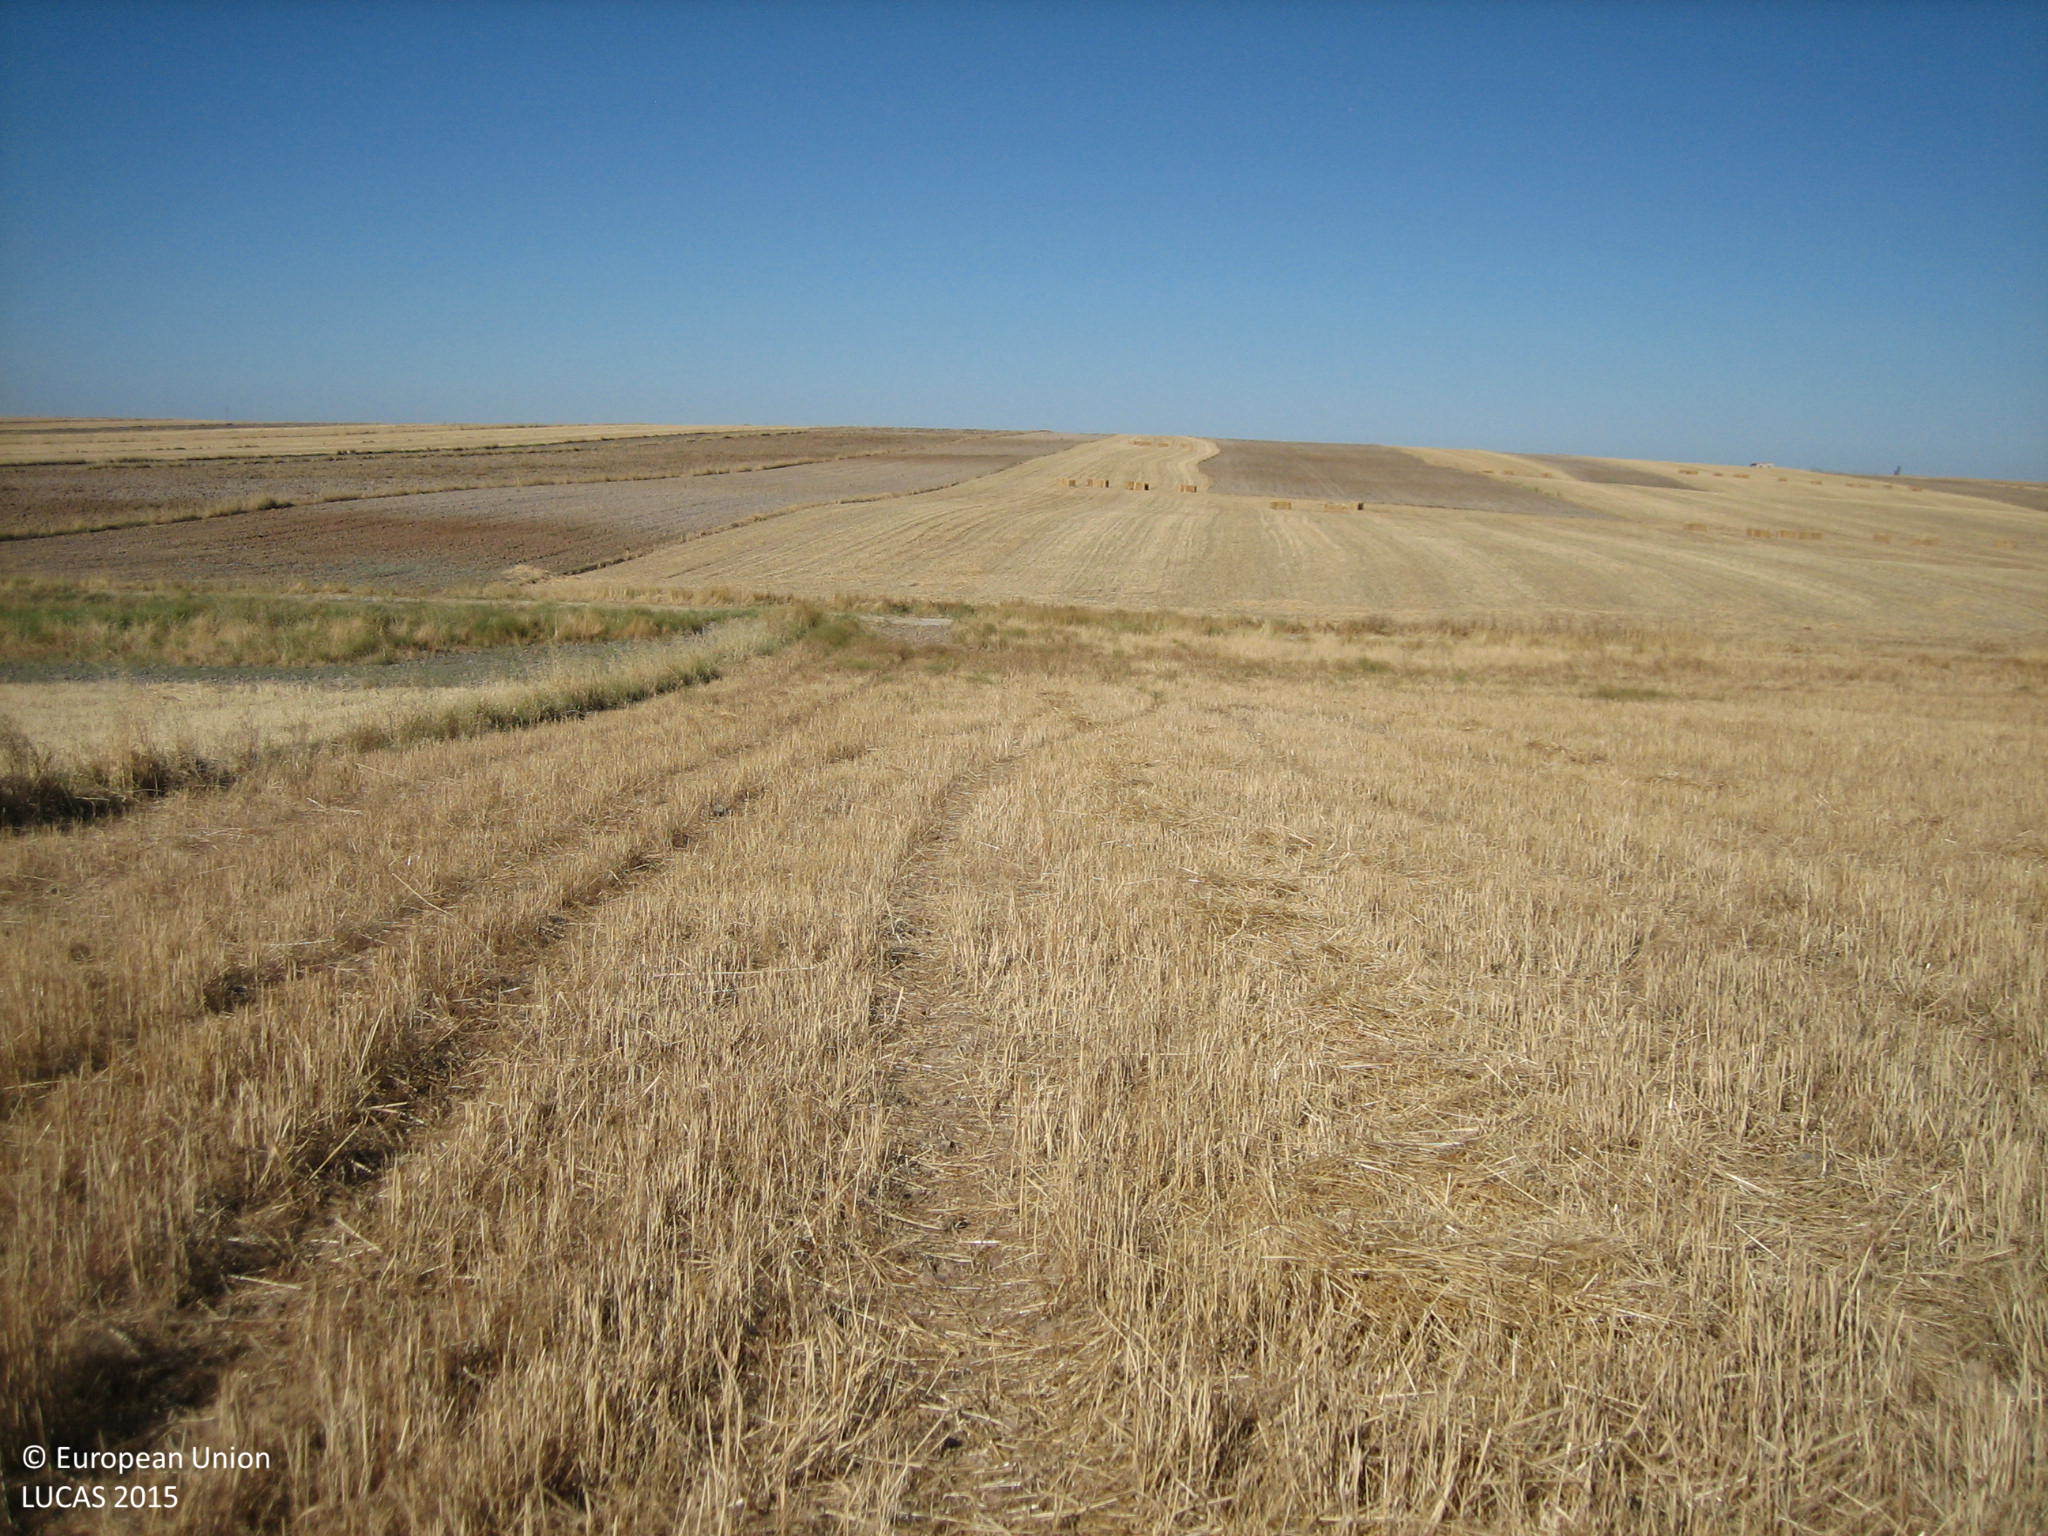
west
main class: Cropland
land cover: Common wheat
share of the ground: < 10 %
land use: Agriculture (excluding fallow land and kitchen gardens)
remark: Harvested field
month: July
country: ES
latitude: 38.2696
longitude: -6.2872
